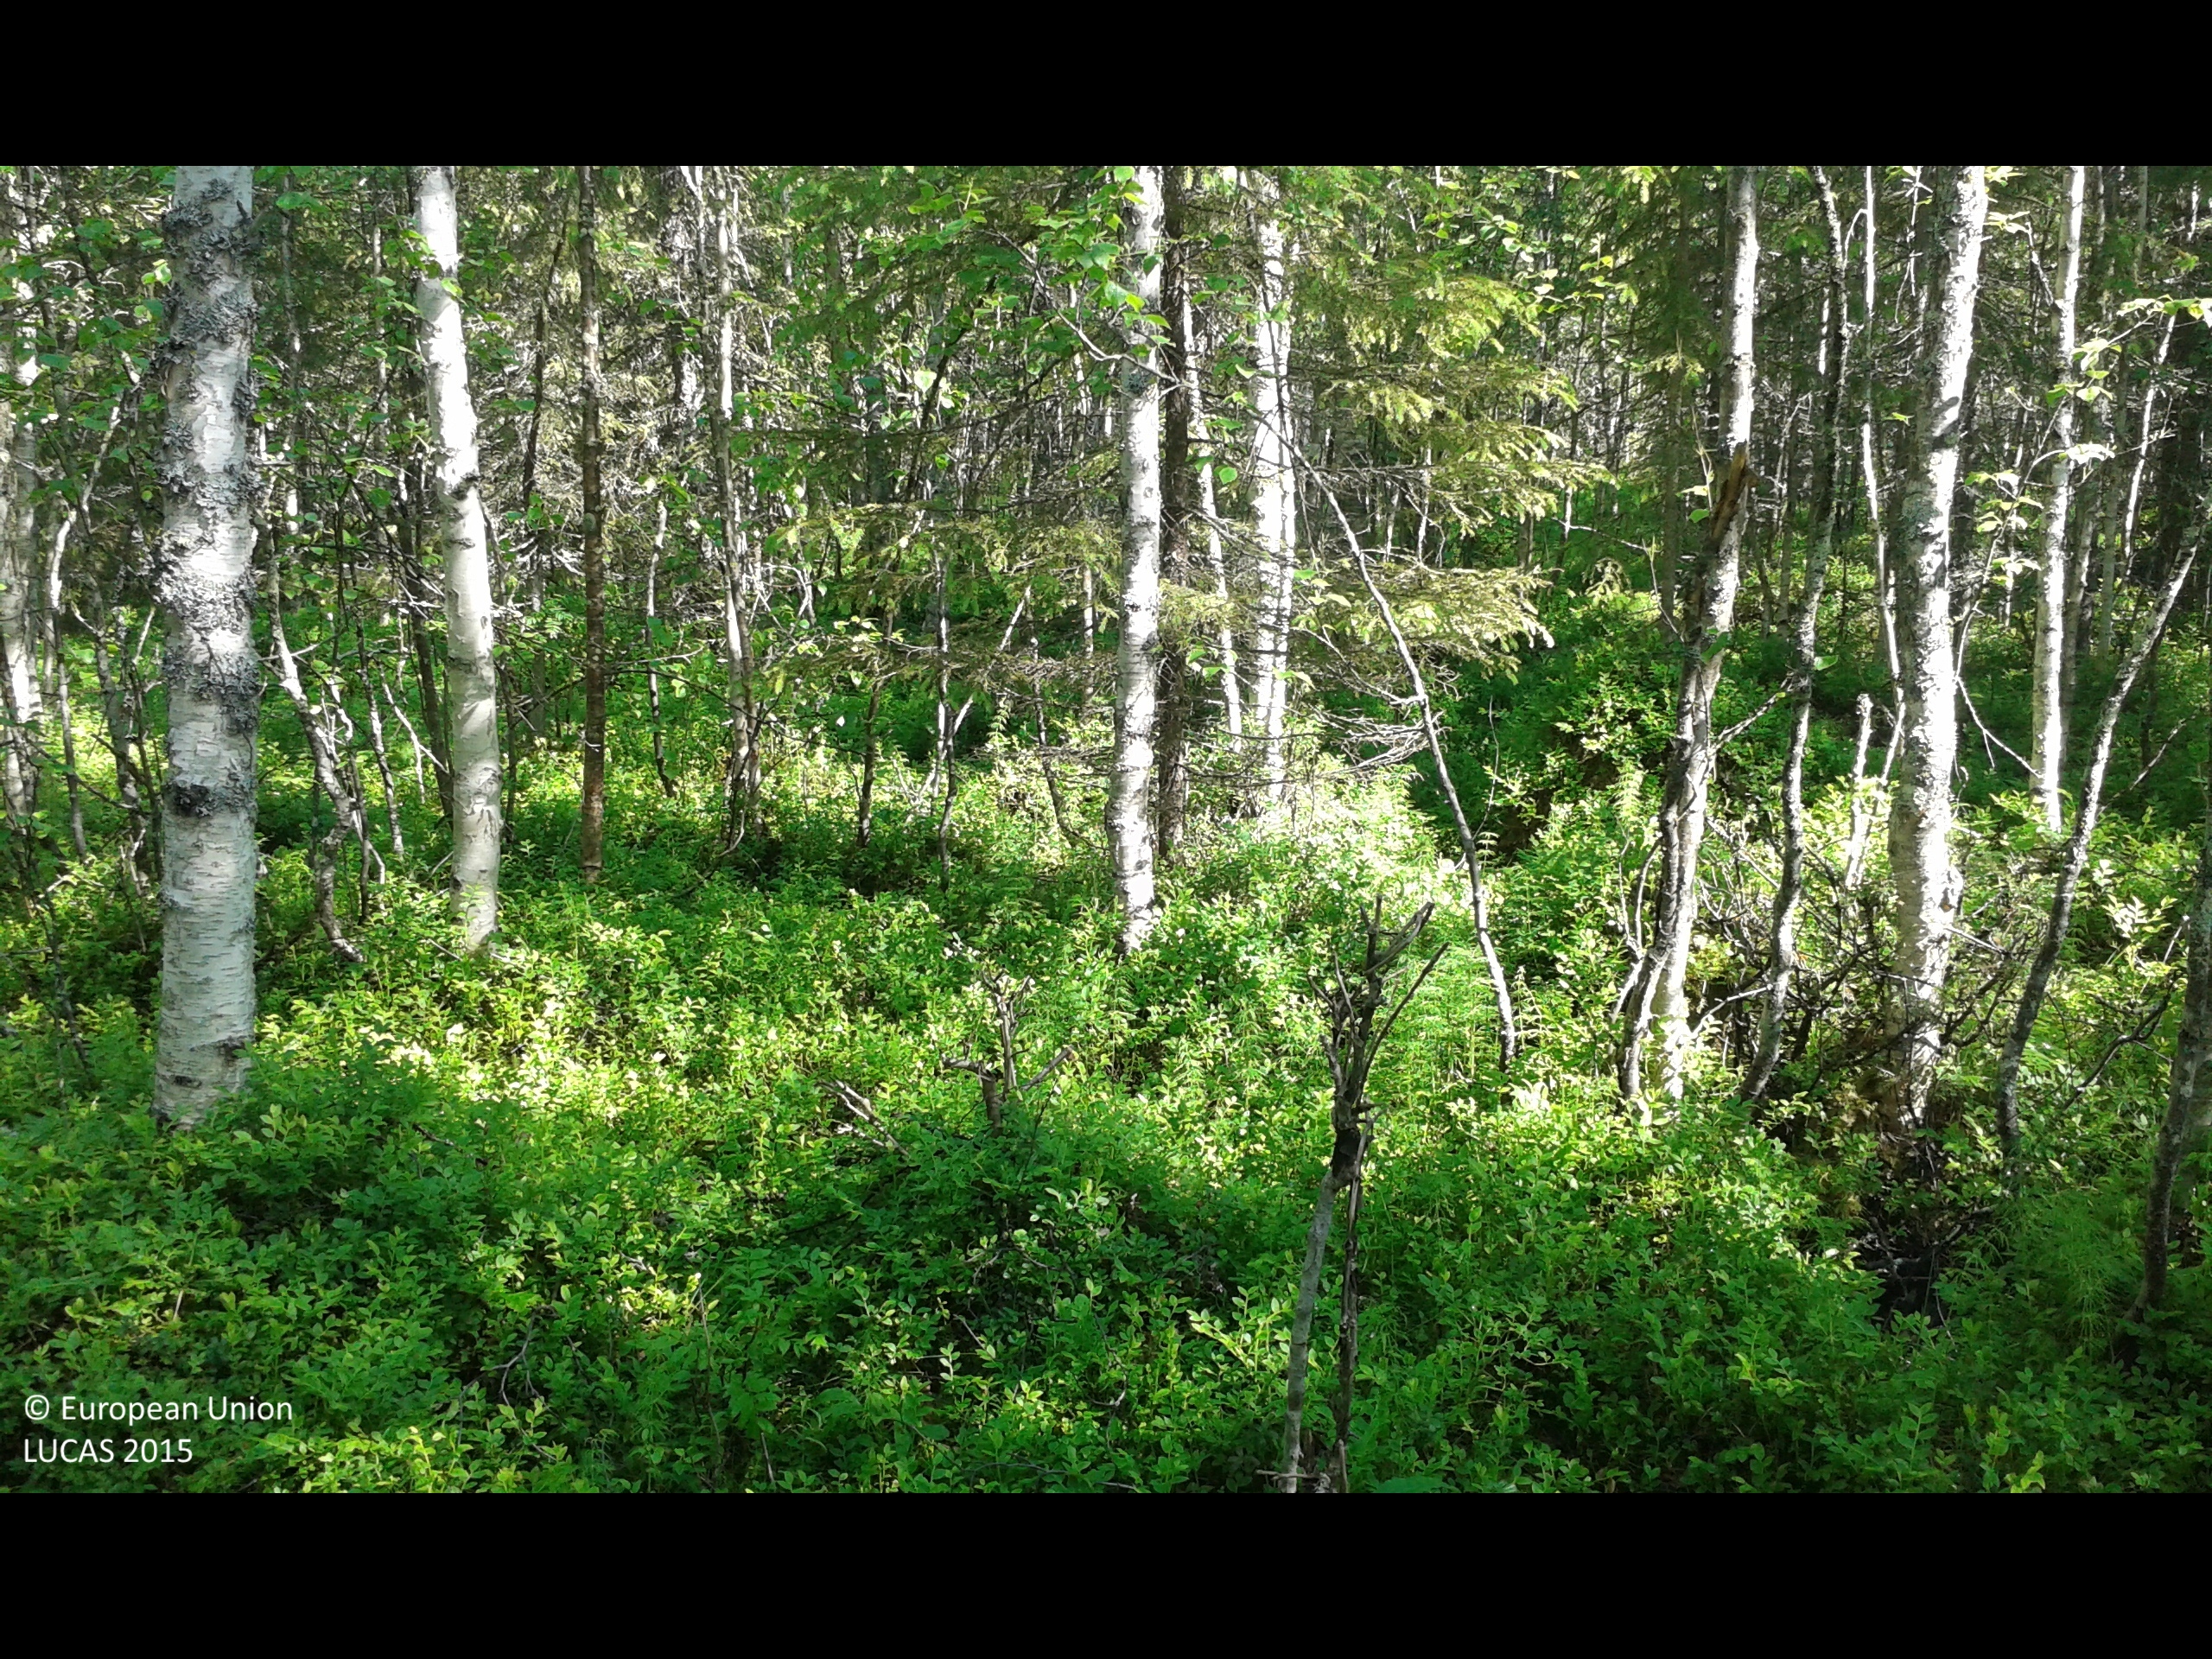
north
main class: Woodland
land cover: Spruce dominated mixed woodland
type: boreal forest
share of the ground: 25 - 50 %
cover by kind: shrubs 55 %, coniferous forest trees 25 %, broadleaved forest trees 20 %
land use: Forestry
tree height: > 5 m
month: July
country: SE
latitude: 66.6186
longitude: 23.6919
